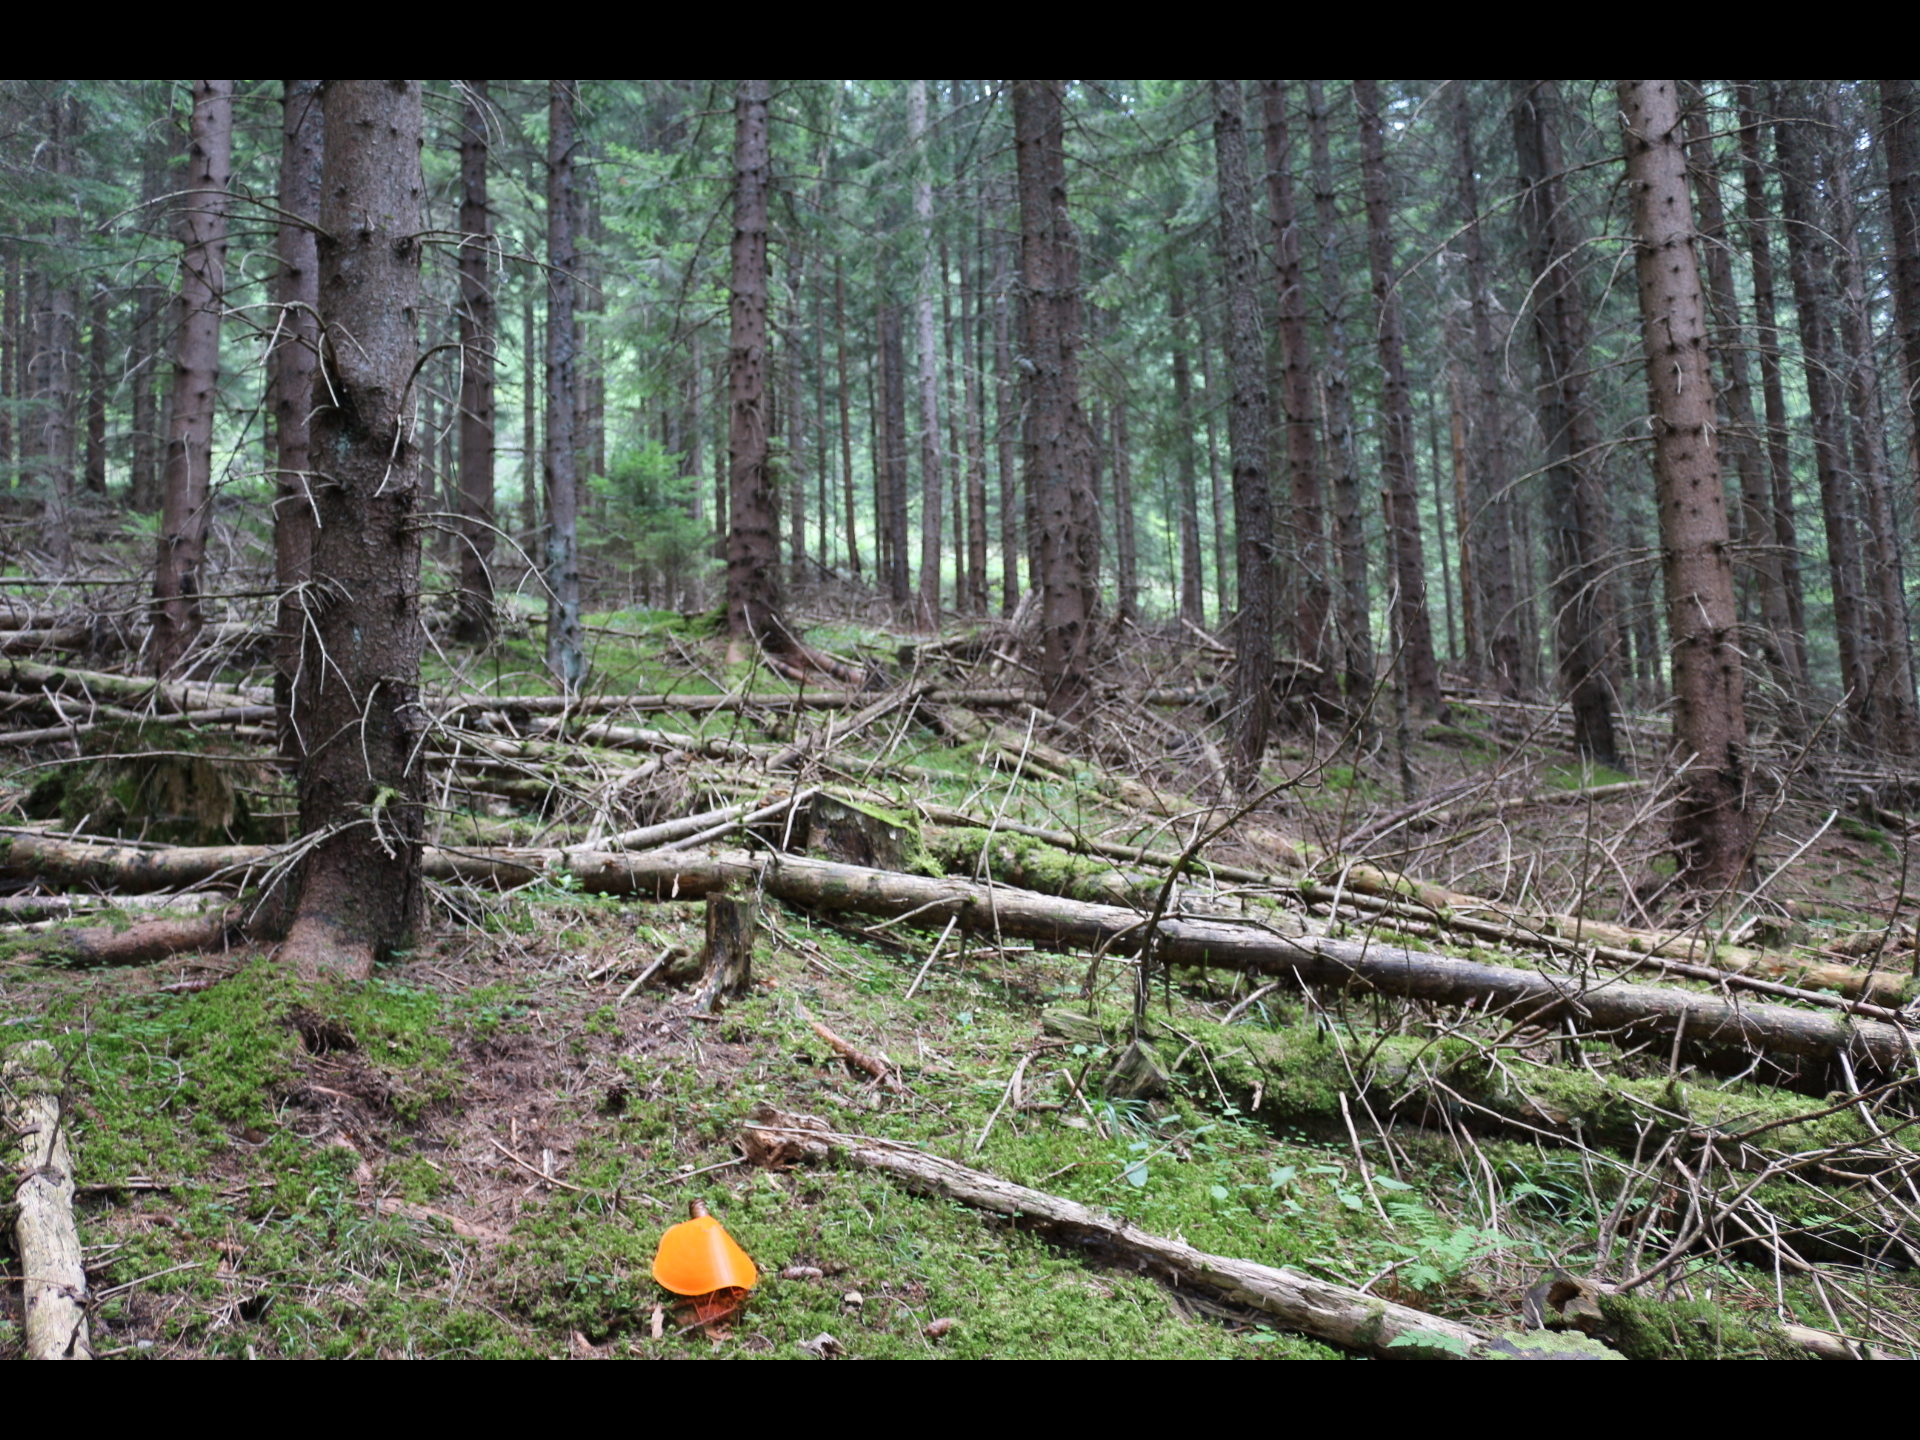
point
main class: Woodland
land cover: Spruce dominated coniferous woodland
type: alpine coniferous forest
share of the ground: > 75 %
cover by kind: coniferous forest trees 85 %, lichens and mosses 10 %, unconsolidated bare surface 5 %
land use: Forestry
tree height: > 5 m
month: August
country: AT
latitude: 46.9414
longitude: 14.0571
